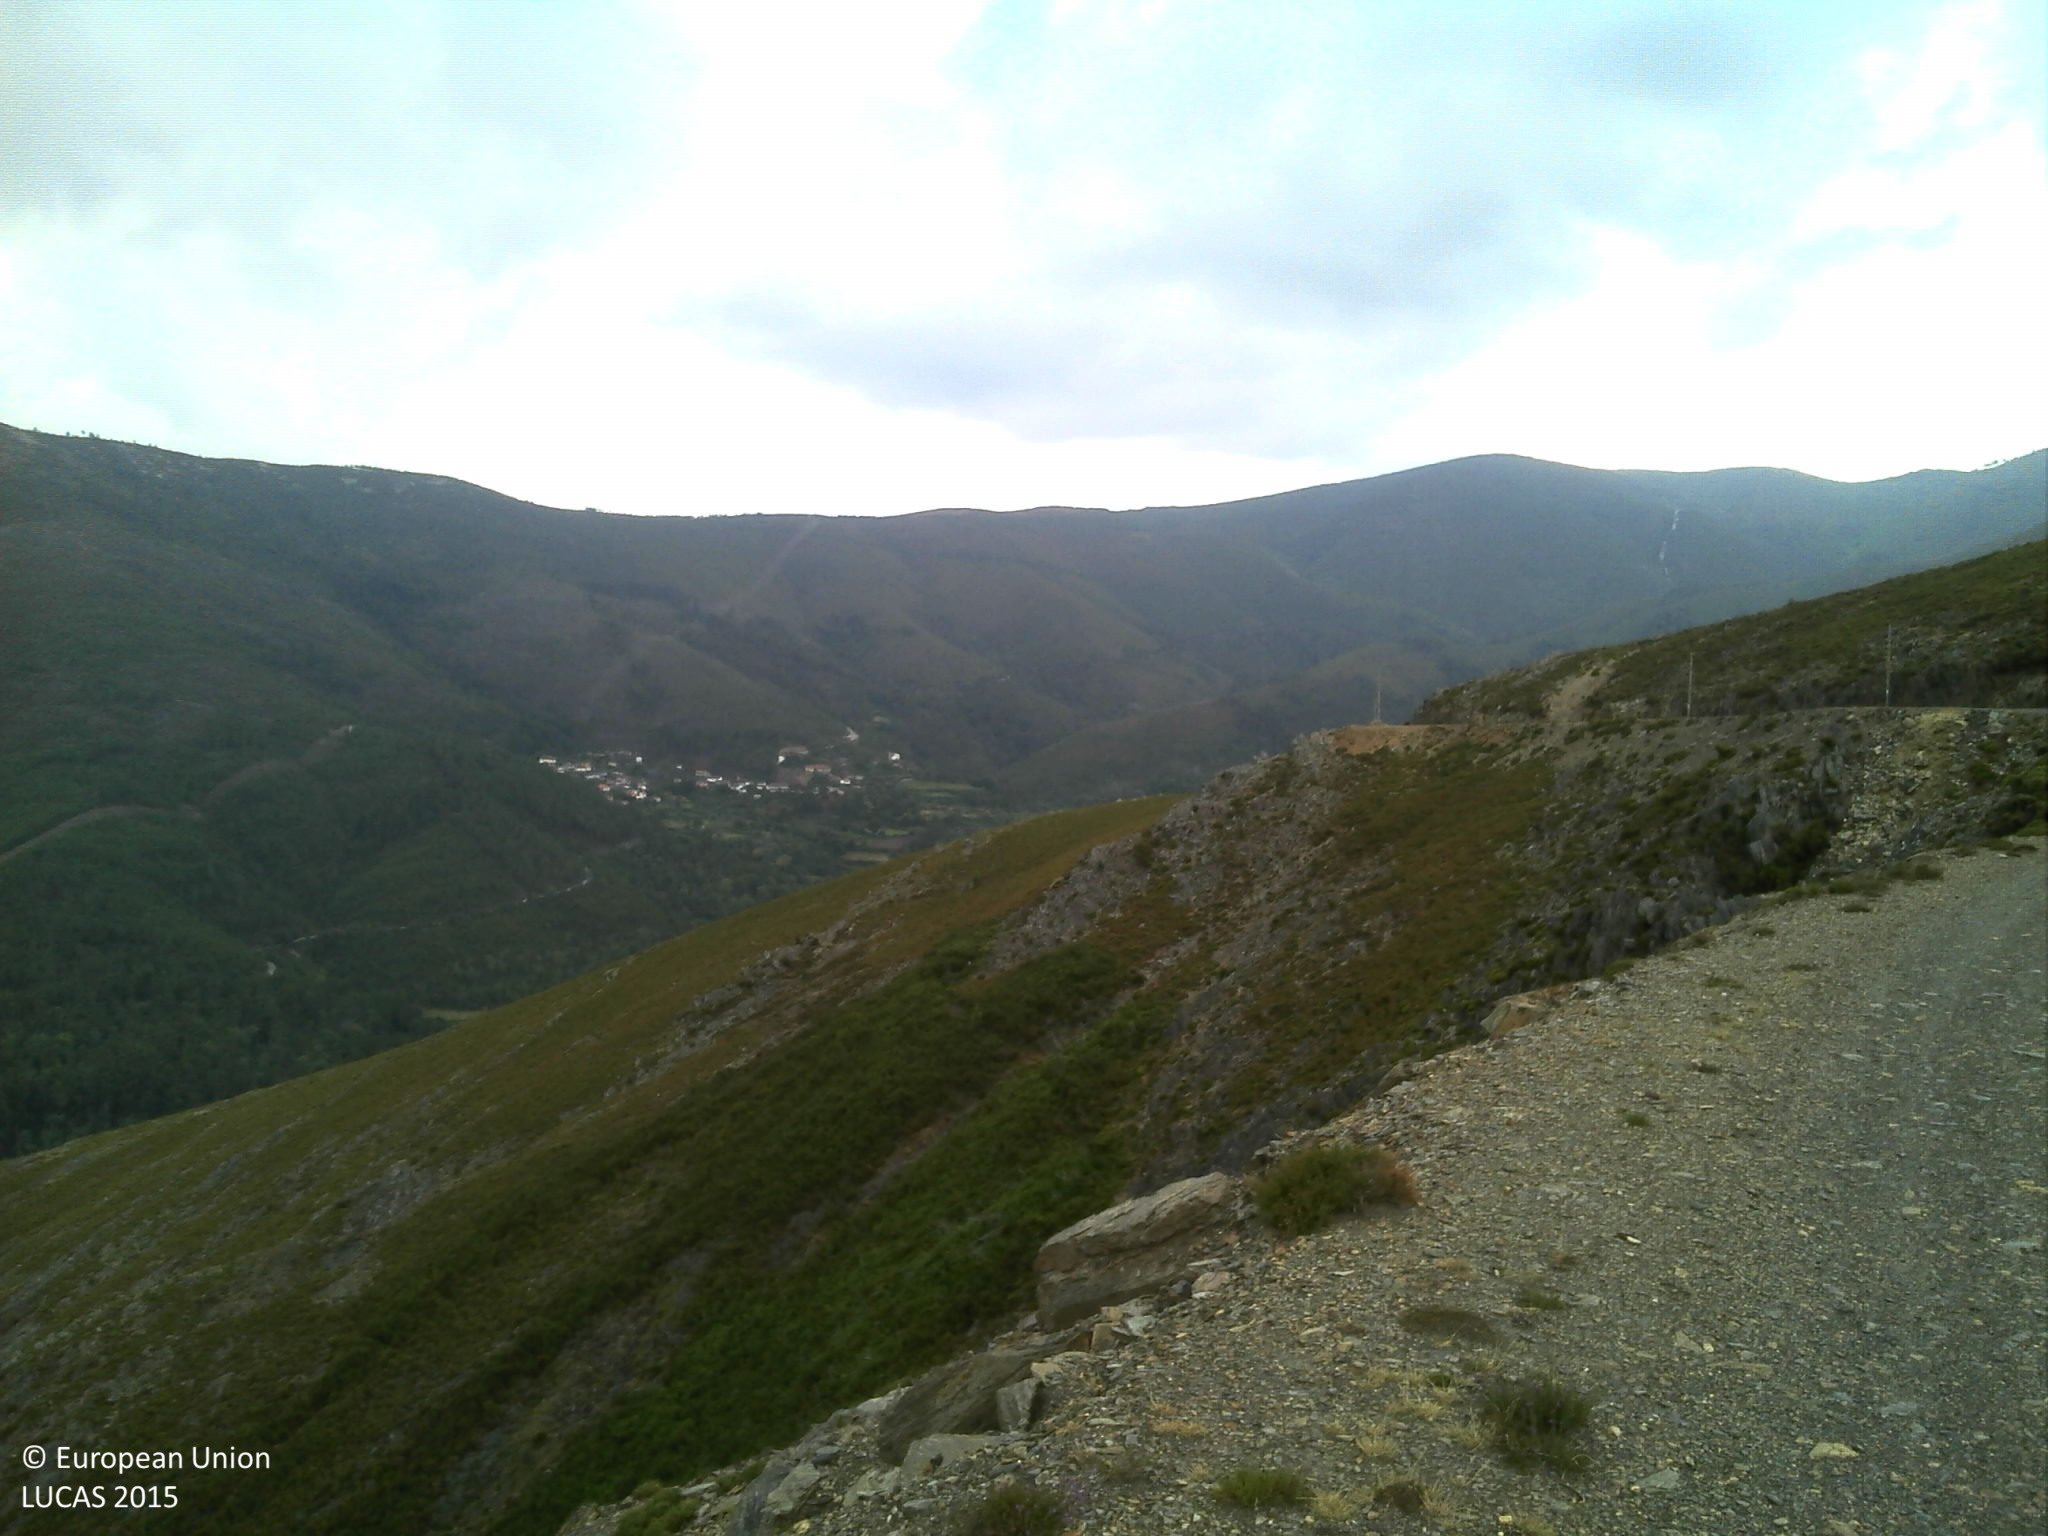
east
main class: Shrubland
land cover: Shrubland without tree cover
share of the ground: > 75 %
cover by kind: shrubs 80 %, consolidated bare surface 15 %, unconsolidated bare surface 5 %
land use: Semi-natural and natural areas not in use
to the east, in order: Shrubland without tree cover; Rocks and stones; Shrubland without tree cover; Rocks and stones; Shrubland without tree cover; Broadleaved woodland; Rivers and streams; Rocks and stones; Shrubland with sparse tree cover; Shrubland without tree cover
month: June
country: PT
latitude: 40.8976
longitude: -8.0929
